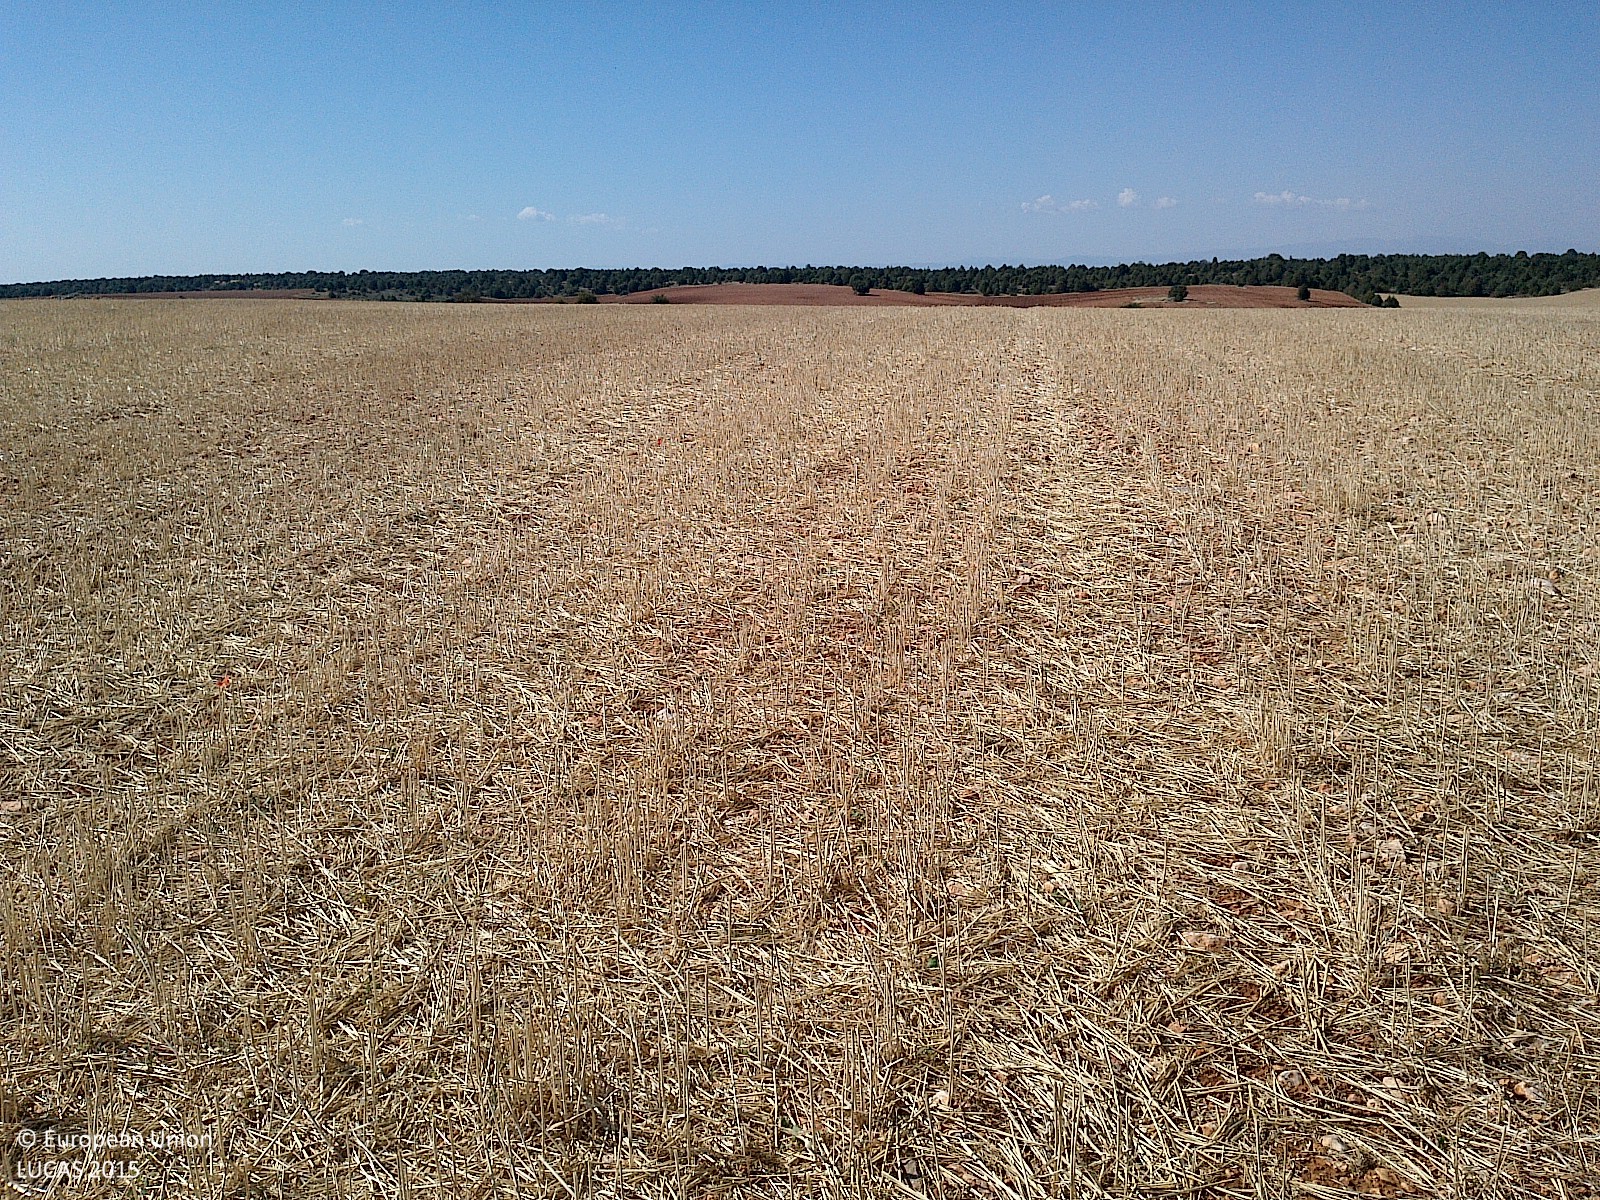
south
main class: Cropland
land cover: Durum wheat
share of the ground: < 10 %
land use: Agriculture (excluding fallow land and kitchen gardens)
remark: Harvested field
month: July
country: ES
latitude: 41.7537
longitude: -3.1674
